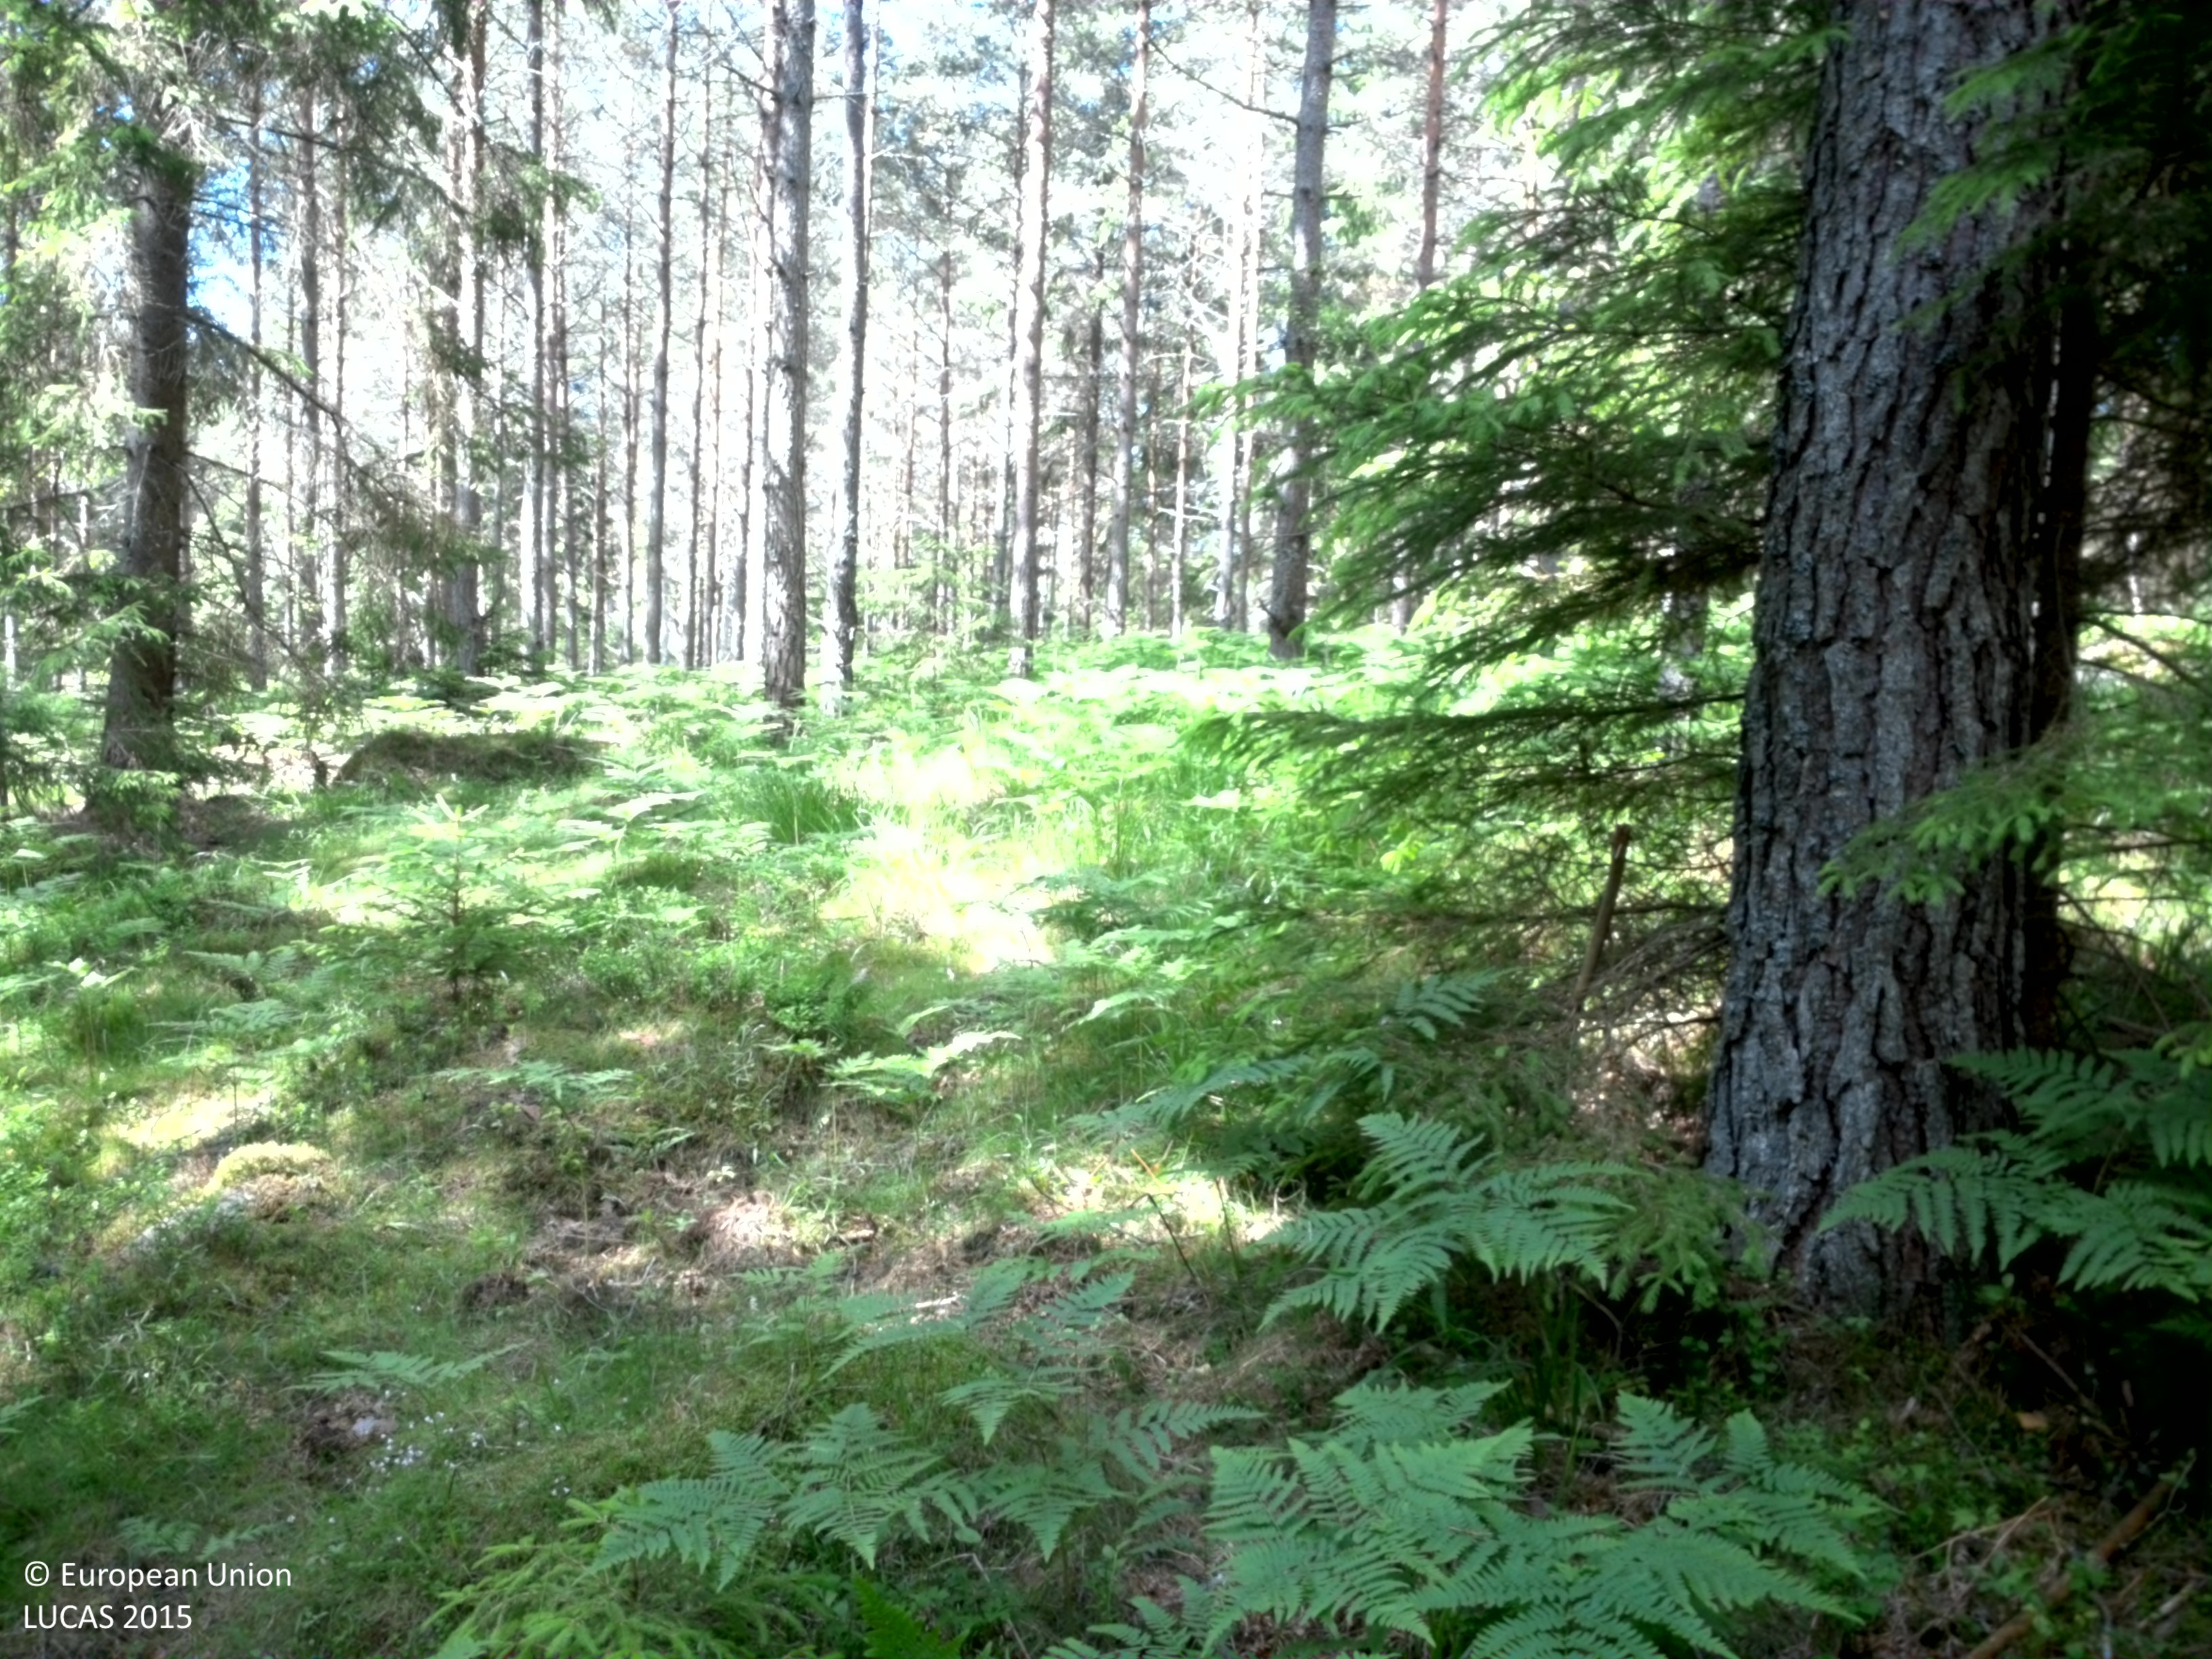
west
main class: Woodland
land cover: Pine dominated coniferous woodland
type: boreal forest
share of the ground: 10 - 25 %
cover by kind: herbaceous plants 60 %, coniferous forest trees 20 %, lichens and mosses 20 %
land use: Community services
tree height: > 5 m
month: June
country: SE
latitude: 58.5974
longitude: 15.4139
